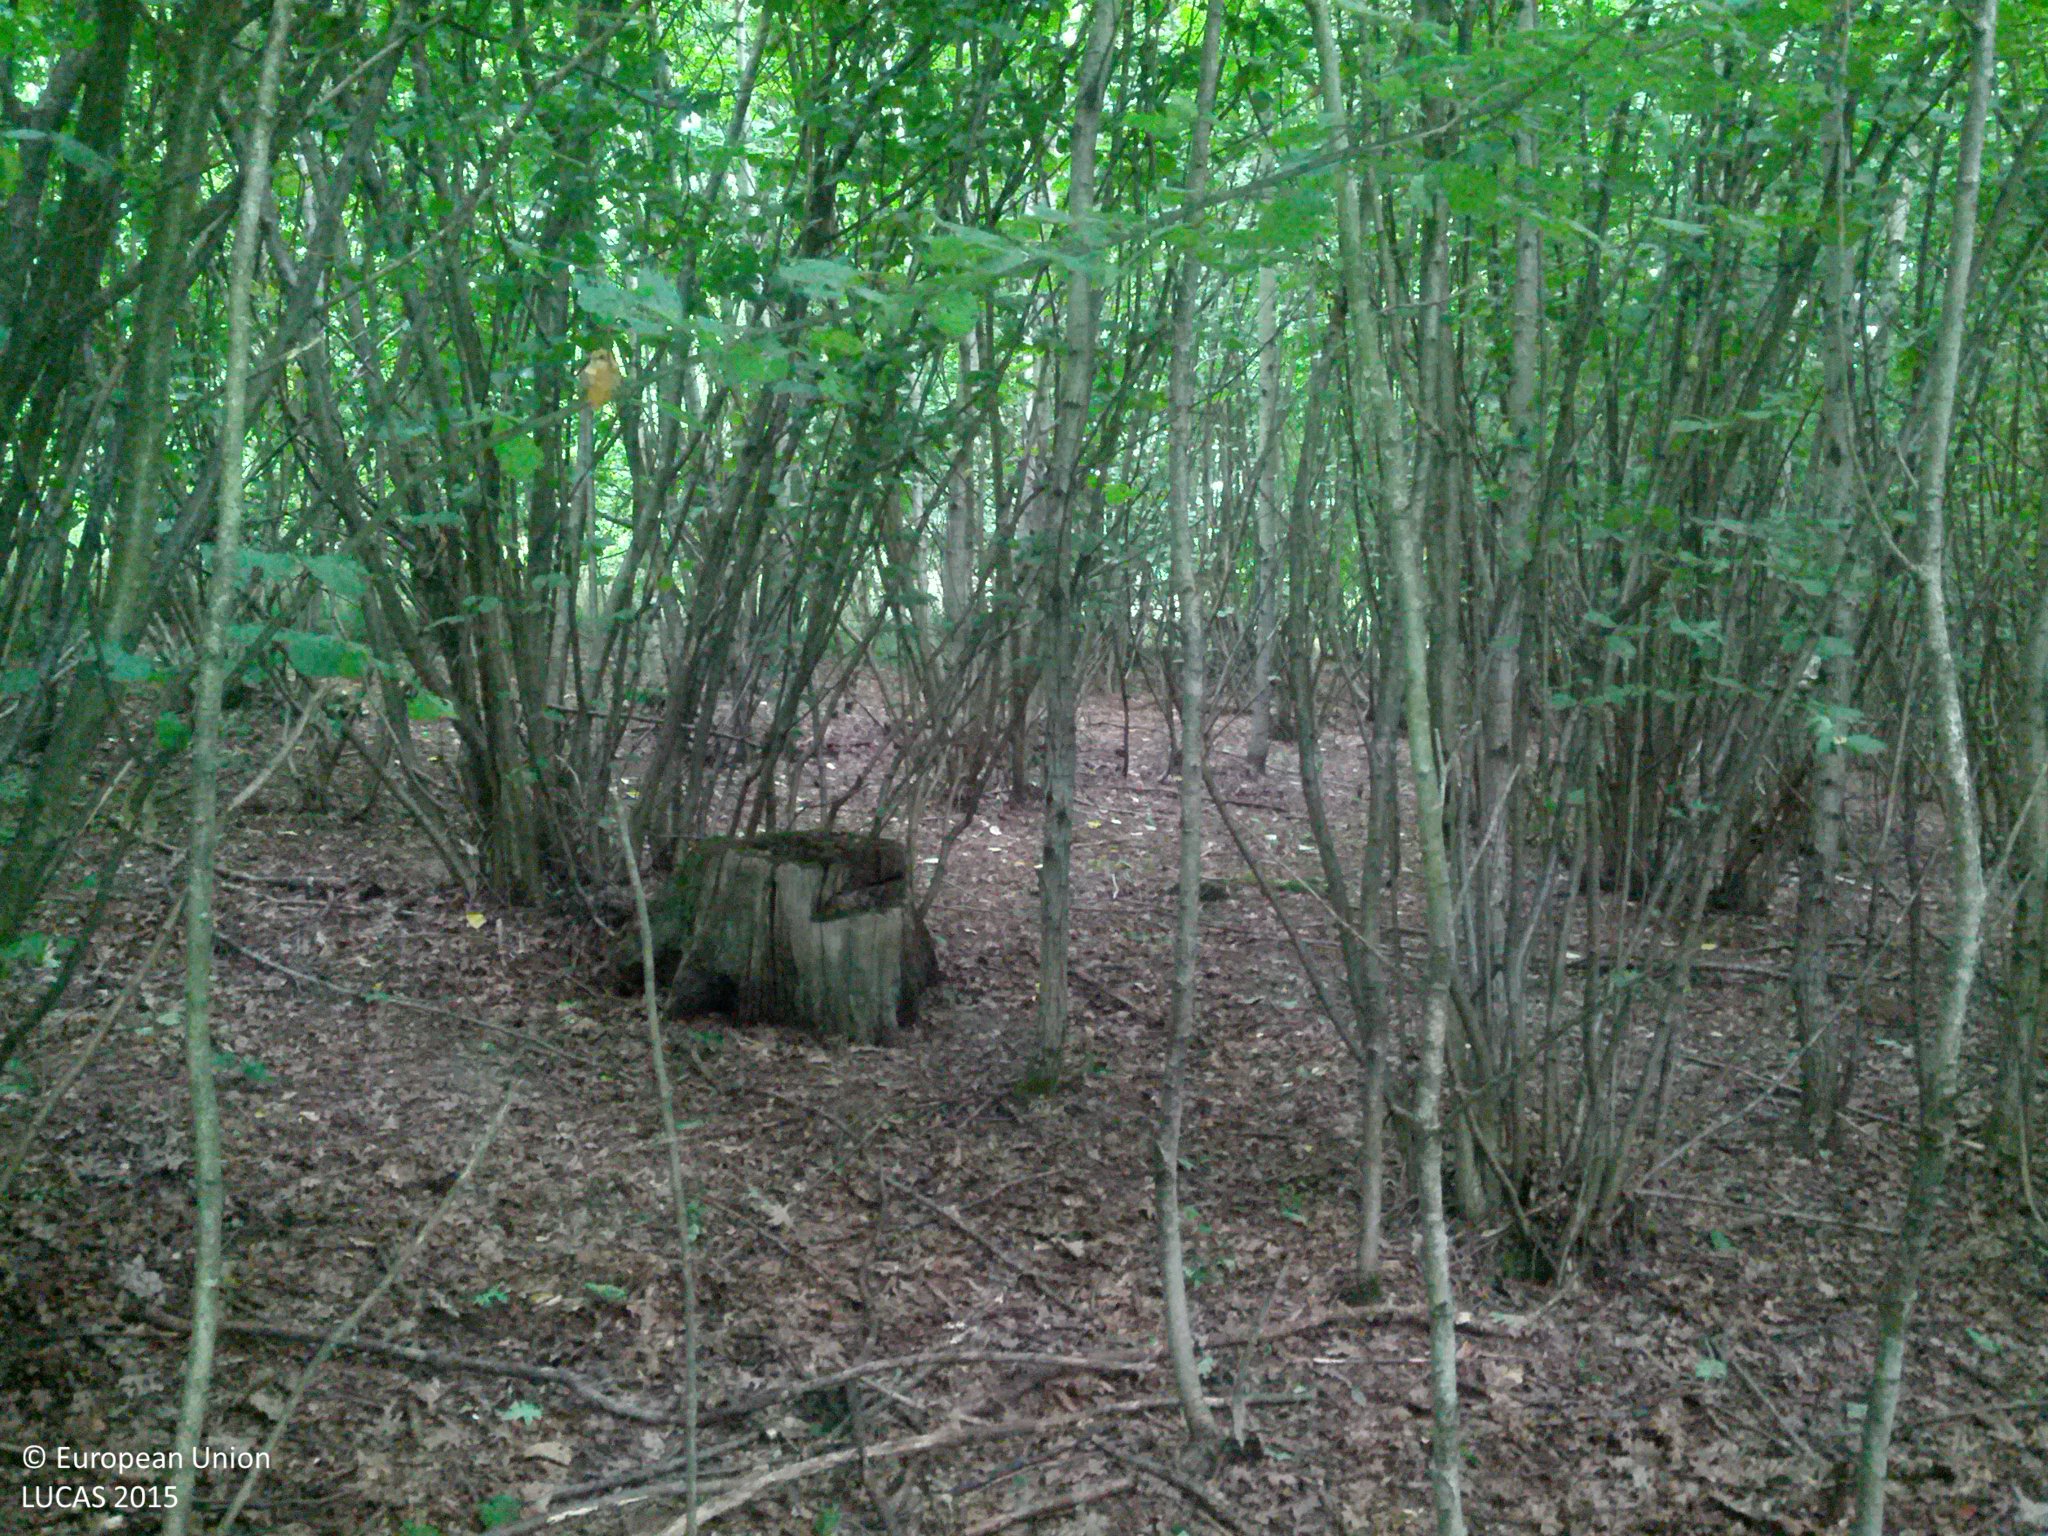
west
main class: Woodland
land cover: Broadleaved woodland
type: thermophilous deciduous forest
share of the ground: > 75 %
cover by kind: broadleaved forest trees 95 %, unconsolidated bare surface 5 %
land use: Forestry
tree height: > 5 m
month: July
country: AT
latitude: 48.5560
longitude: 16.1695
